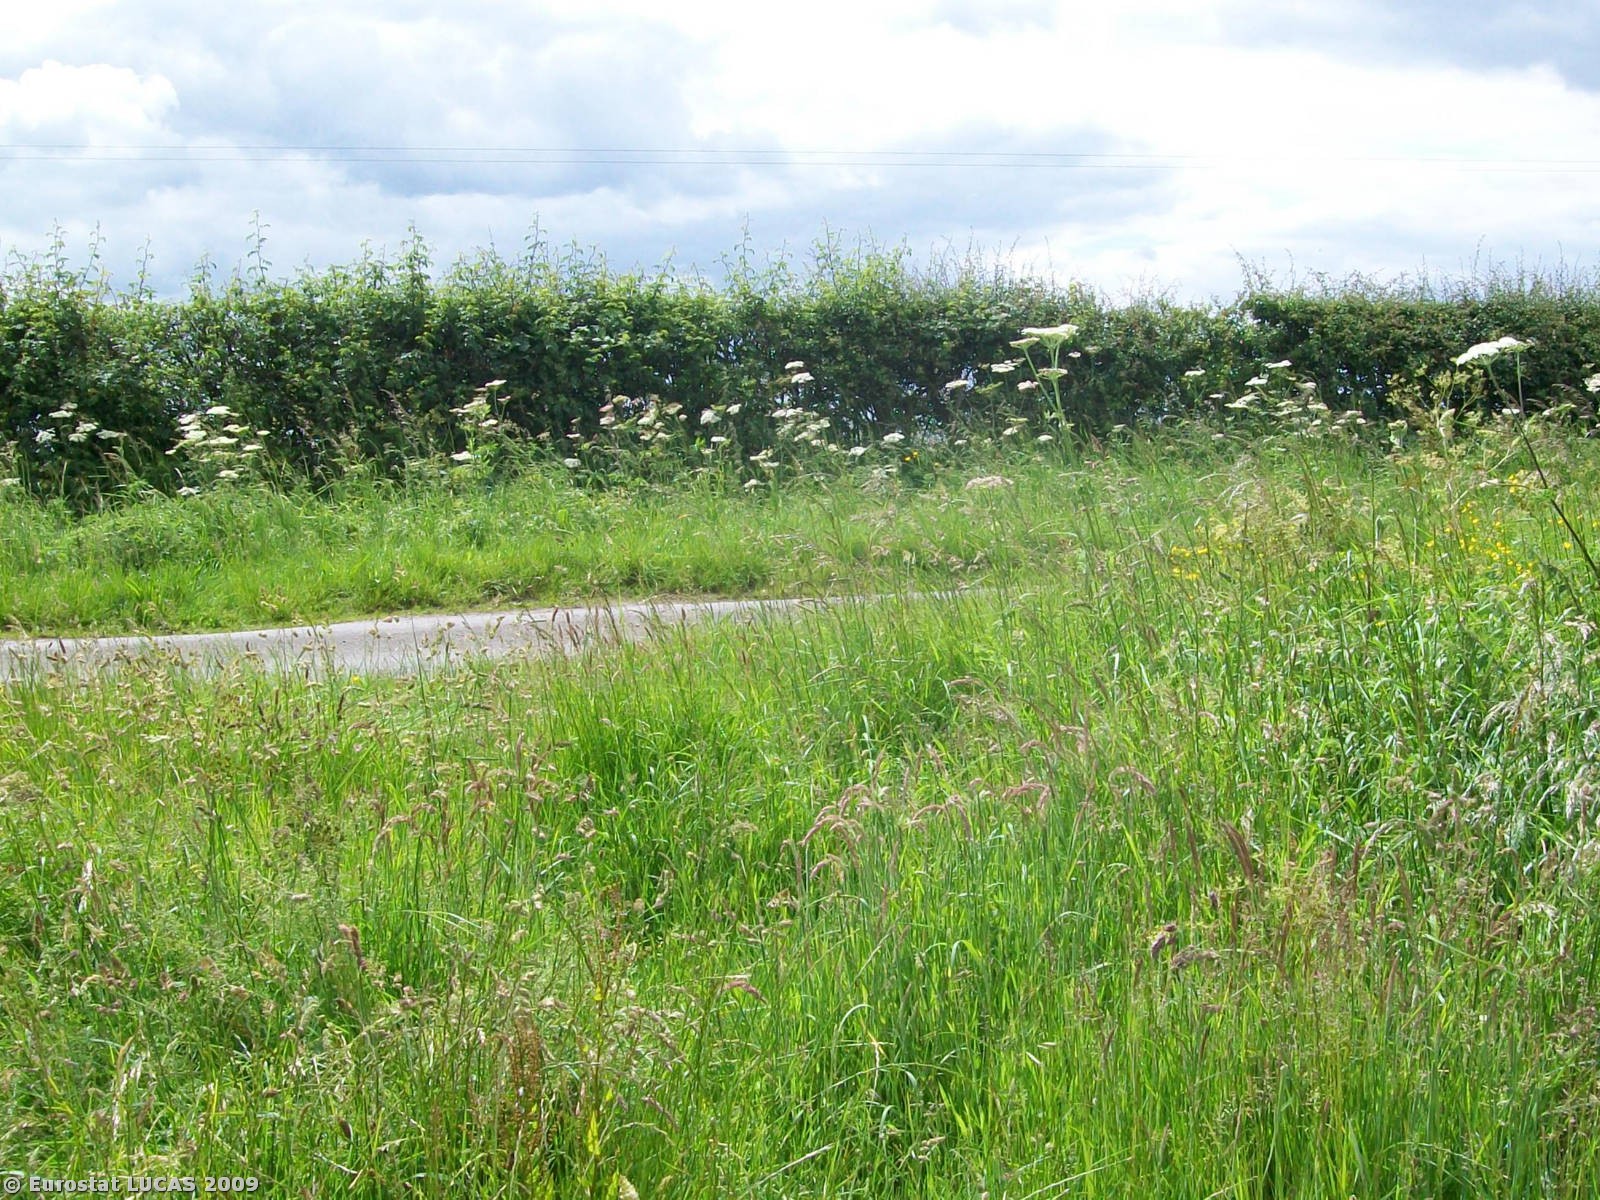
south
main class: Cropland
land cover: Rape and turnip rape
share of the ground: > 75 %
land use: Agriculture (excluding fallow land and kitchen gardens)
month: June
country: GB
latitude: 53.2768
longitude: -0.2171
